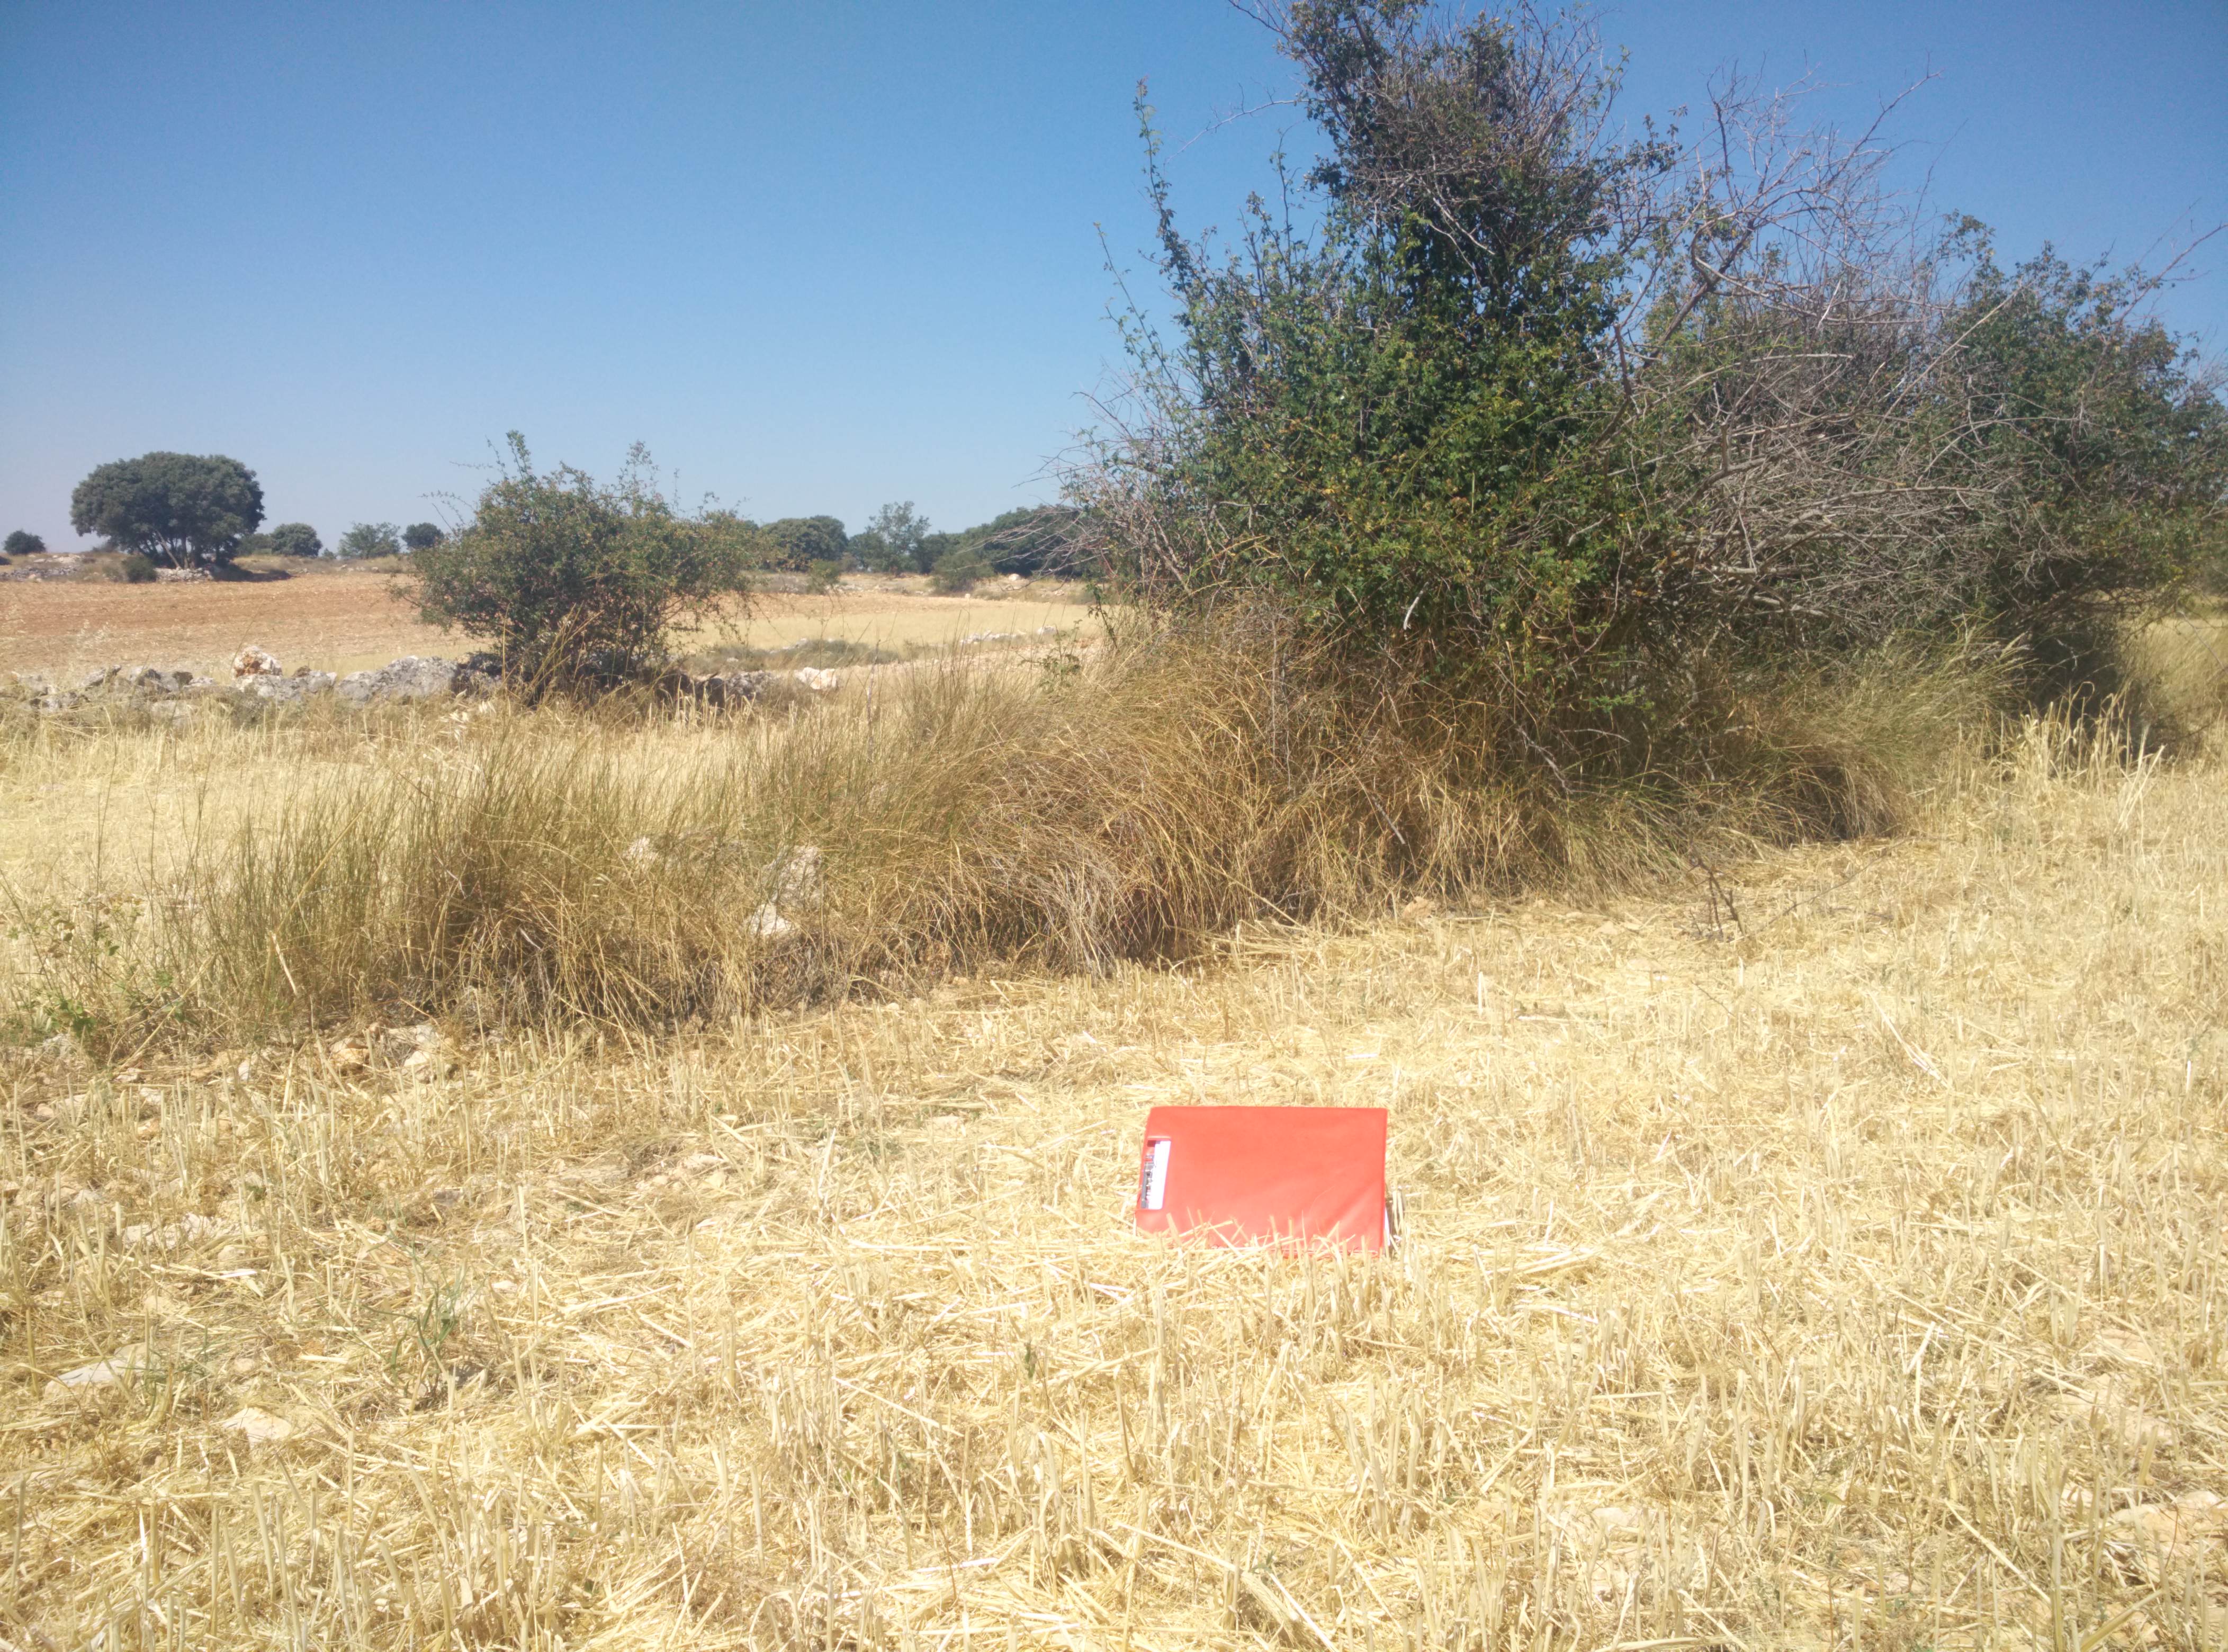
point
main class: Cropland
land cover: Barley
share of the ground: < 10 %
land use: Agriculture (excluding fallow land and kitchen gardens)
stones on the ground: > 50 %
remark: Harvested field
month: July
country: ES
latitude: 40.9127
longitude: -2.8917
